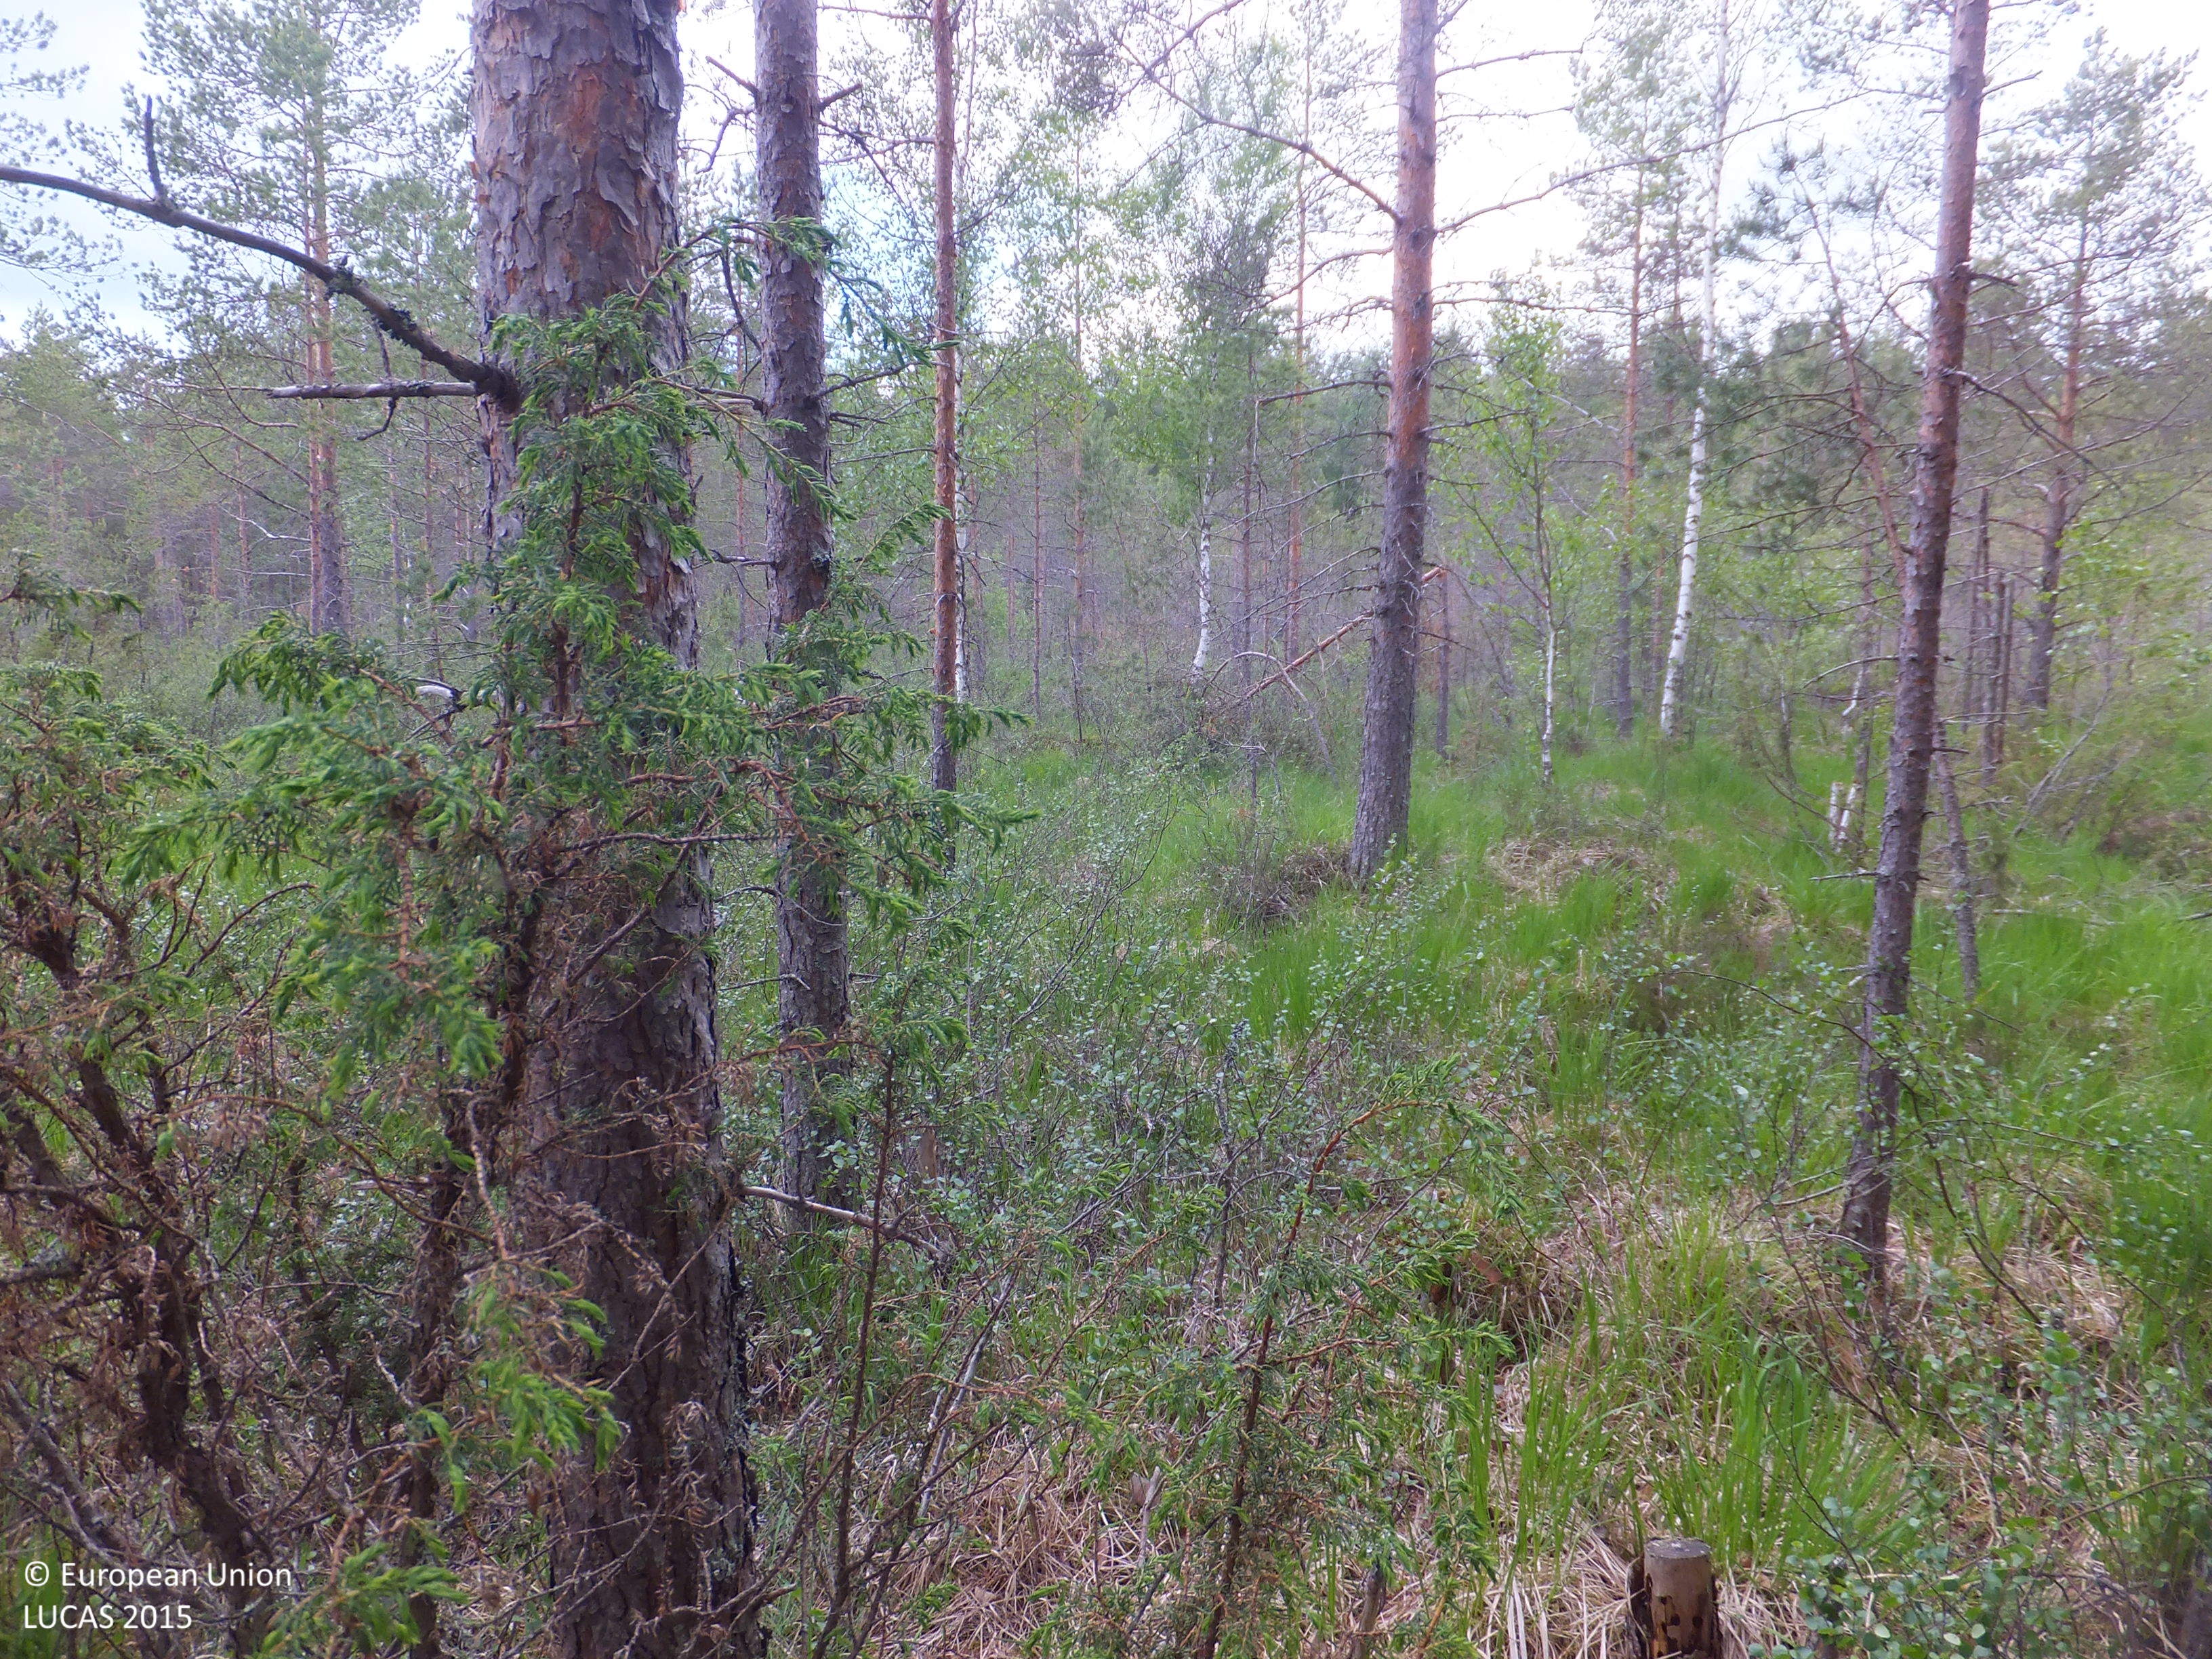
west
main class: Woodland
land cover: Pine dominated mixed woodland
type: boreal forest
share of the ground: 50 - 75 %
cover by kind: coniferous forest trees 40 %, broadleaved forest trees 20 %, herbaceous plants 15 %, lichens and mosses 15 %, shrubs 10 %
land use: Forestry
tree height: > 5 m
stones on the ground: < 10 %
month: June
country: FI
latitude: 63.3992
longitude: 24.2688
